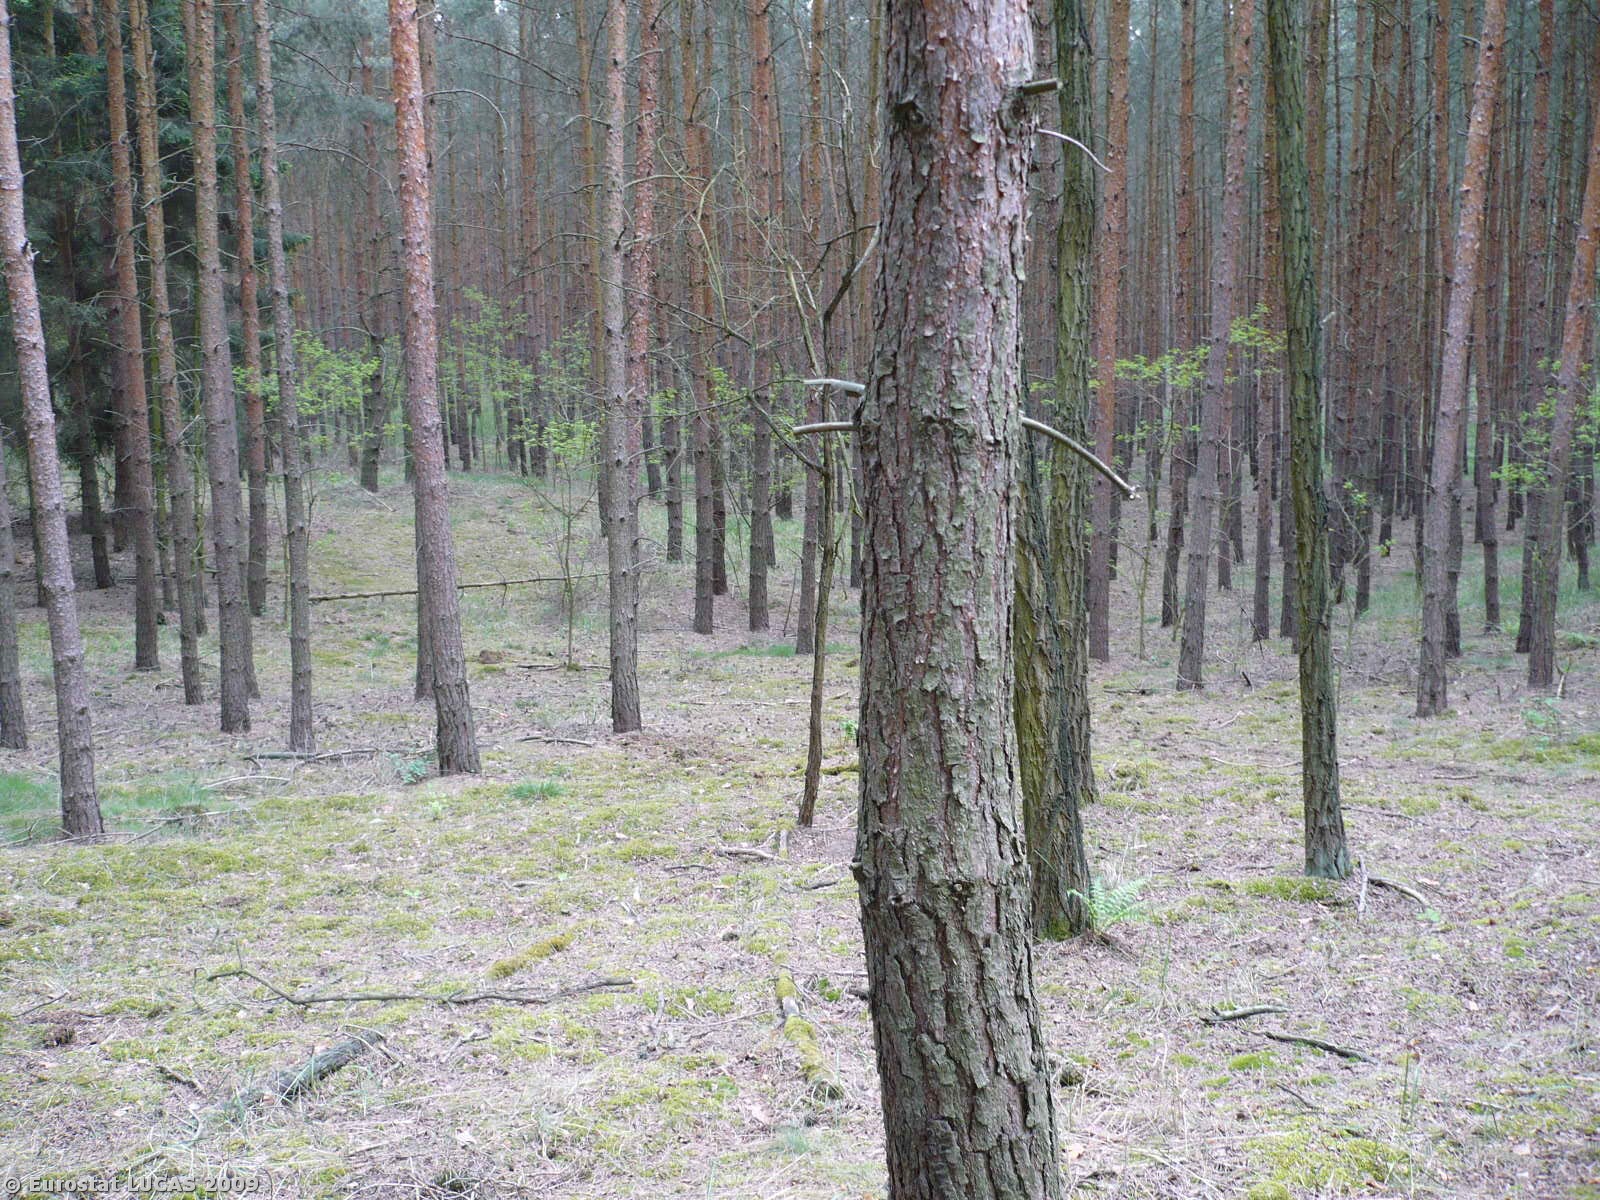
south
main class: Woodland
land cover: Coniferous woodland
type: hemiboreal forest and nemoral coniferous forest and mixed broadleaved-coniferous forest
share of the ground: > 75 %
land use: Forestry
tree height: > 5 m
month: May
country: PL
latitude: 52.0614
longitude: 15.6785
